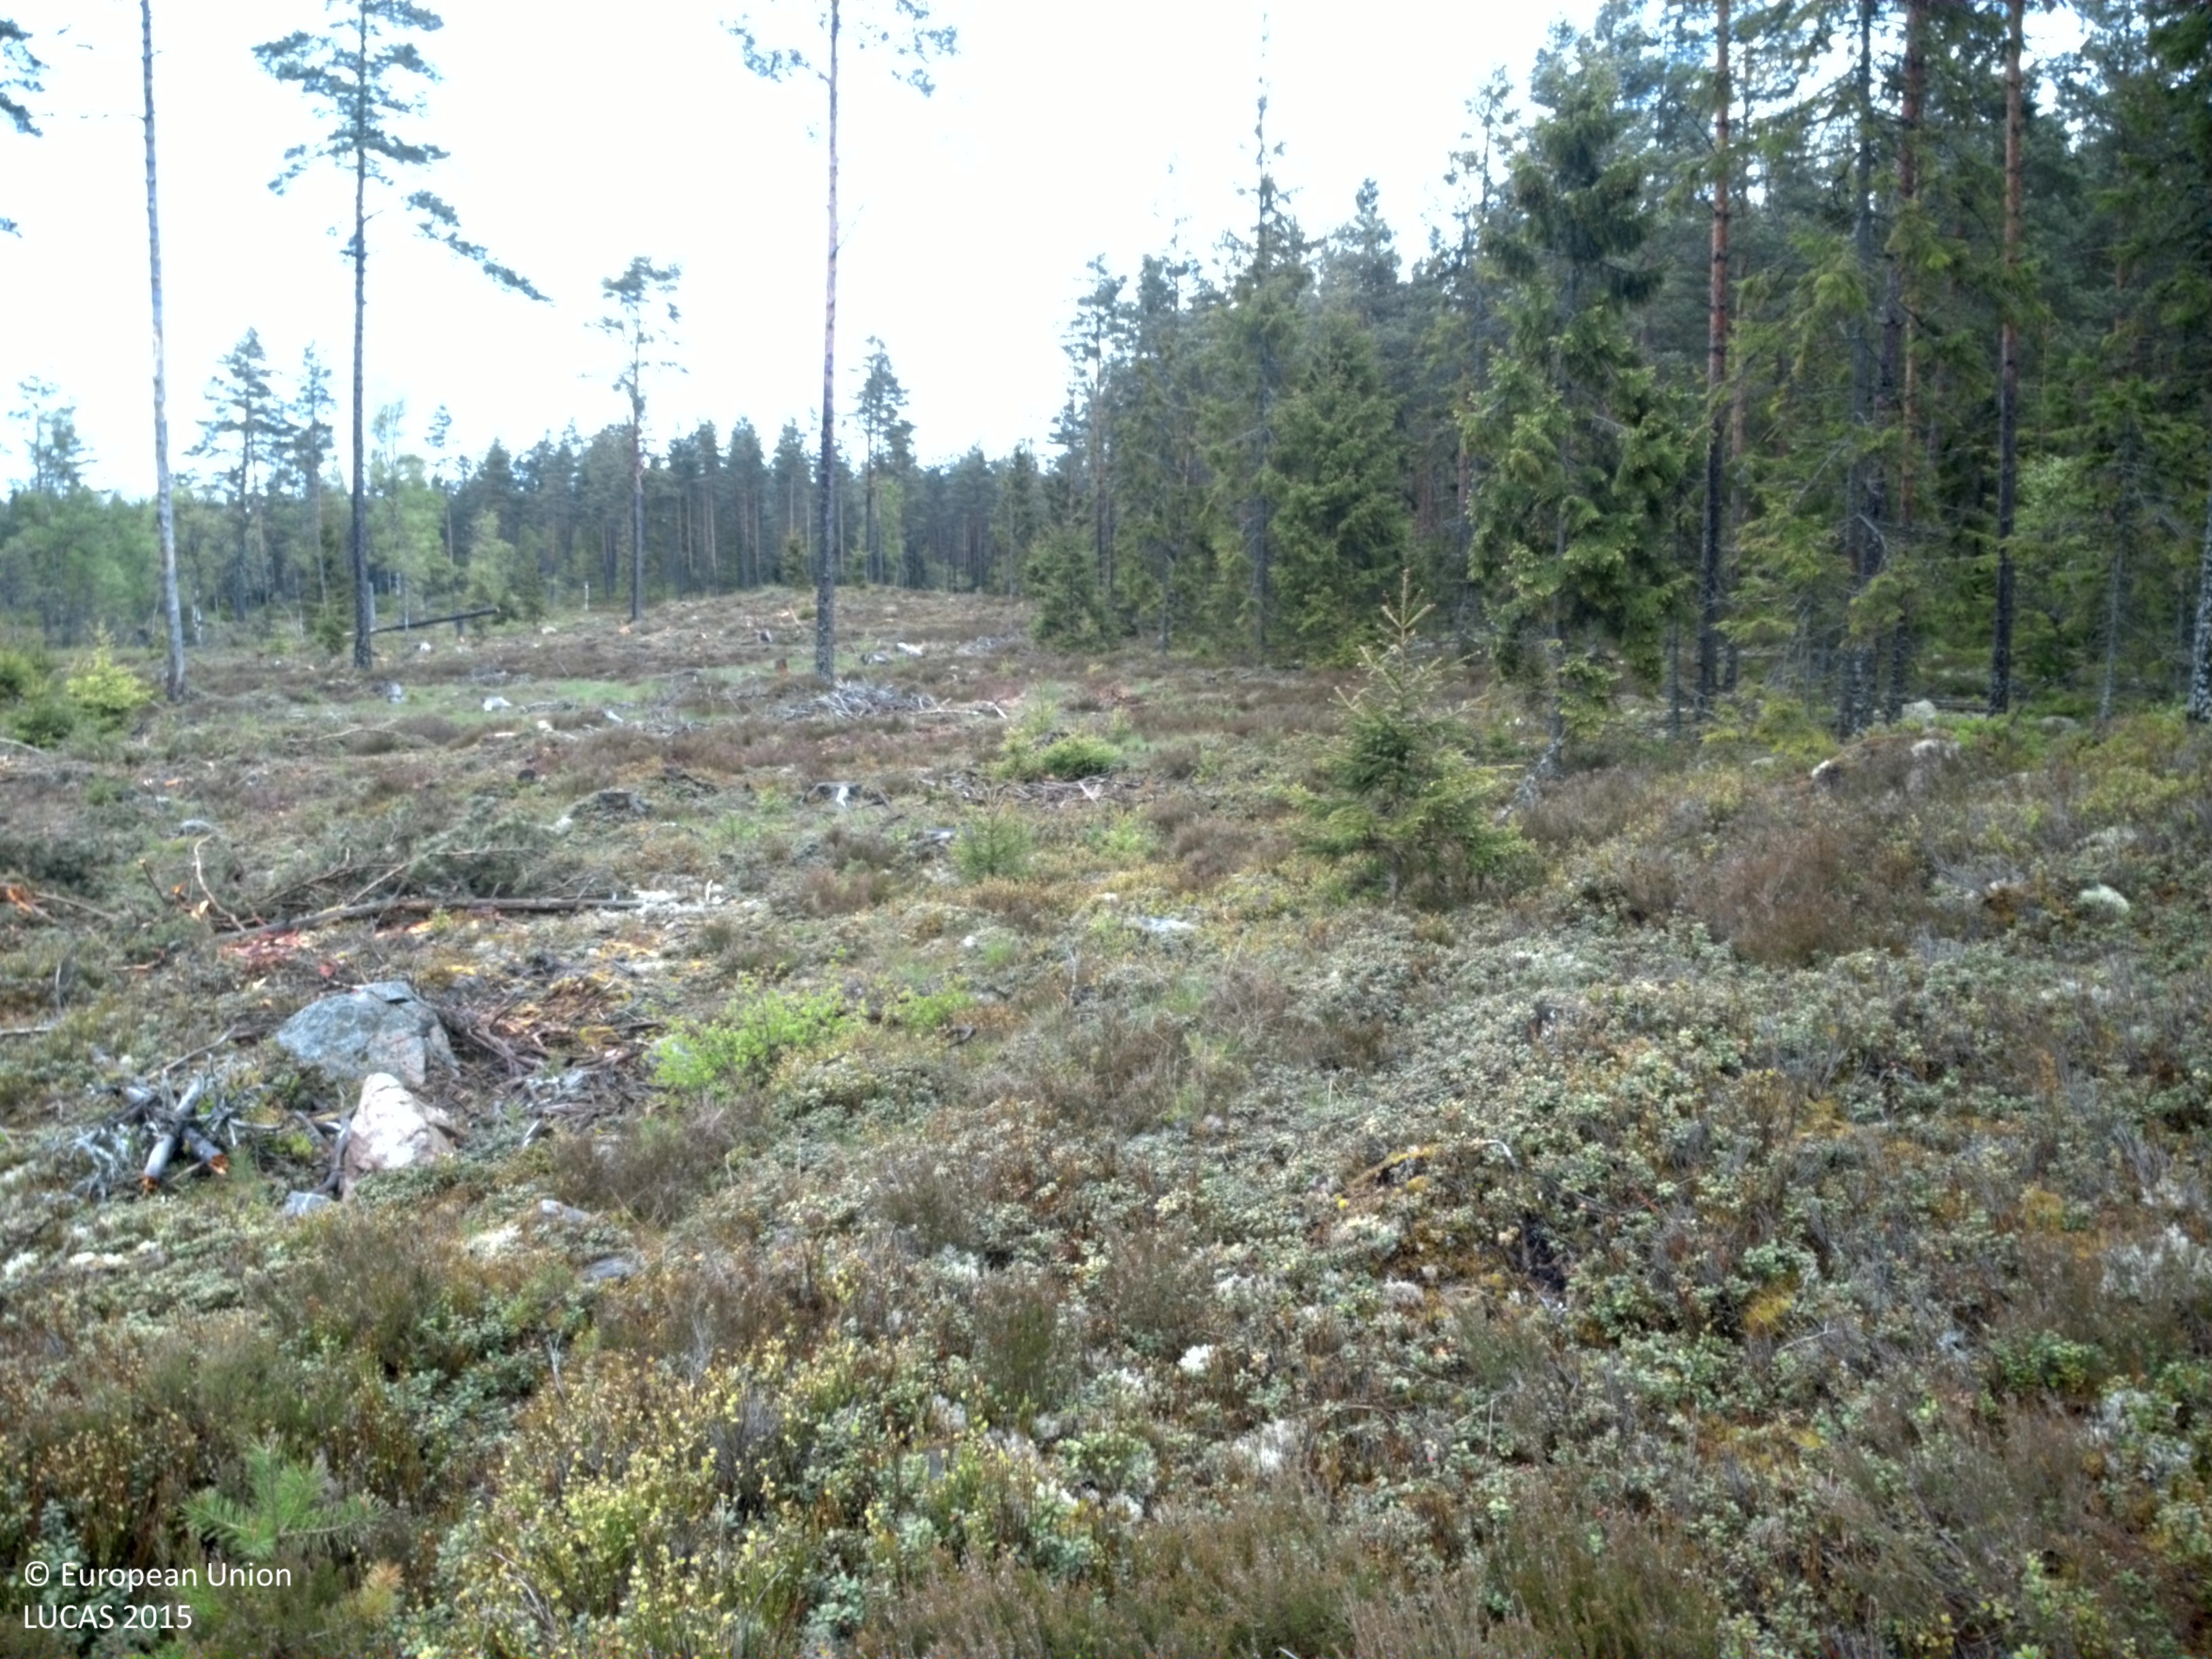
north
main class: Woodland
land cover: Pine dominated coniferous woodland
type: boreal forest
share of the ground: 10 - 25 %
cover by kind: shrubs 50 %, lichens and mosses 20 %, coniferous forest trees 15 %, herbaceous plants 15 %
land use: Forestry
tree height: < 5 m
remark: Clear cut
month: May
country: SE
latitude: 56.9005
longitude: 15.4656
